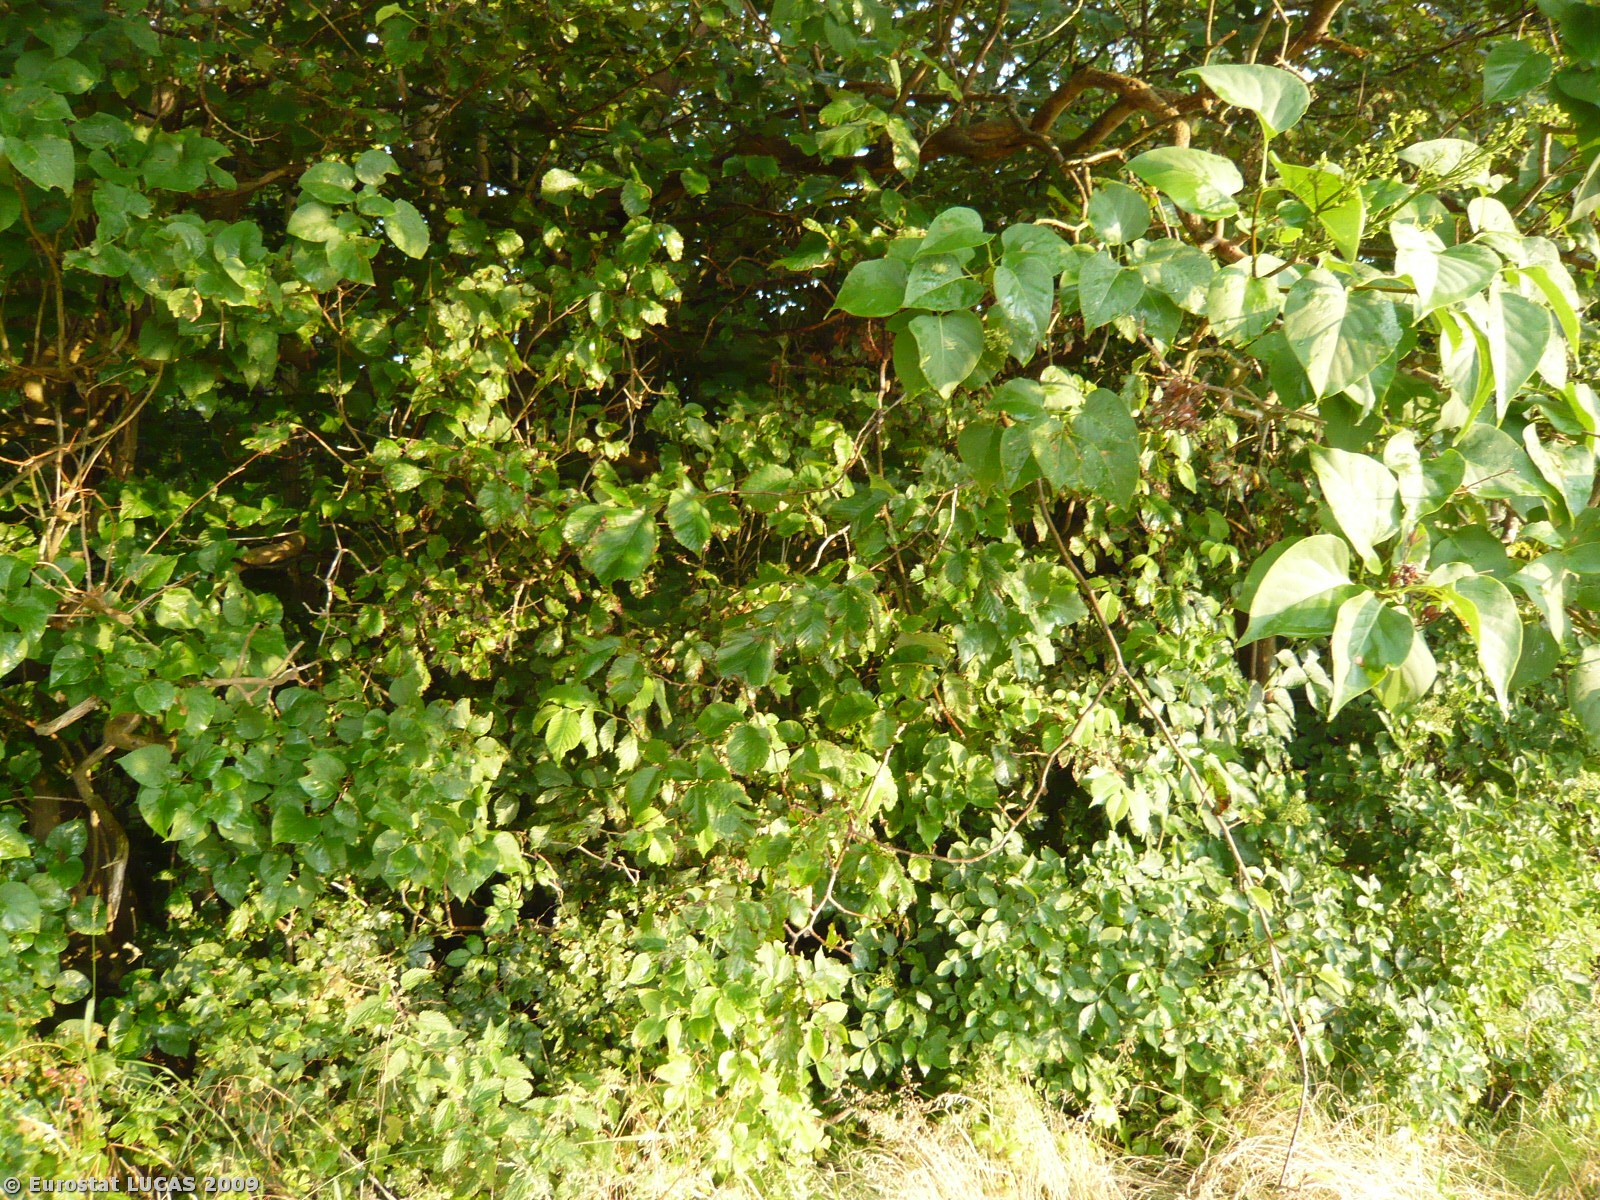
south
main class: Cropland
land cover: Temporary grasslands
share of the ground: > 75 %
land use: Agriculture (excluding fallow land and kitchen gardens)
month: July
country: DK
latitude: 55.6773
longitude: 11.3504
